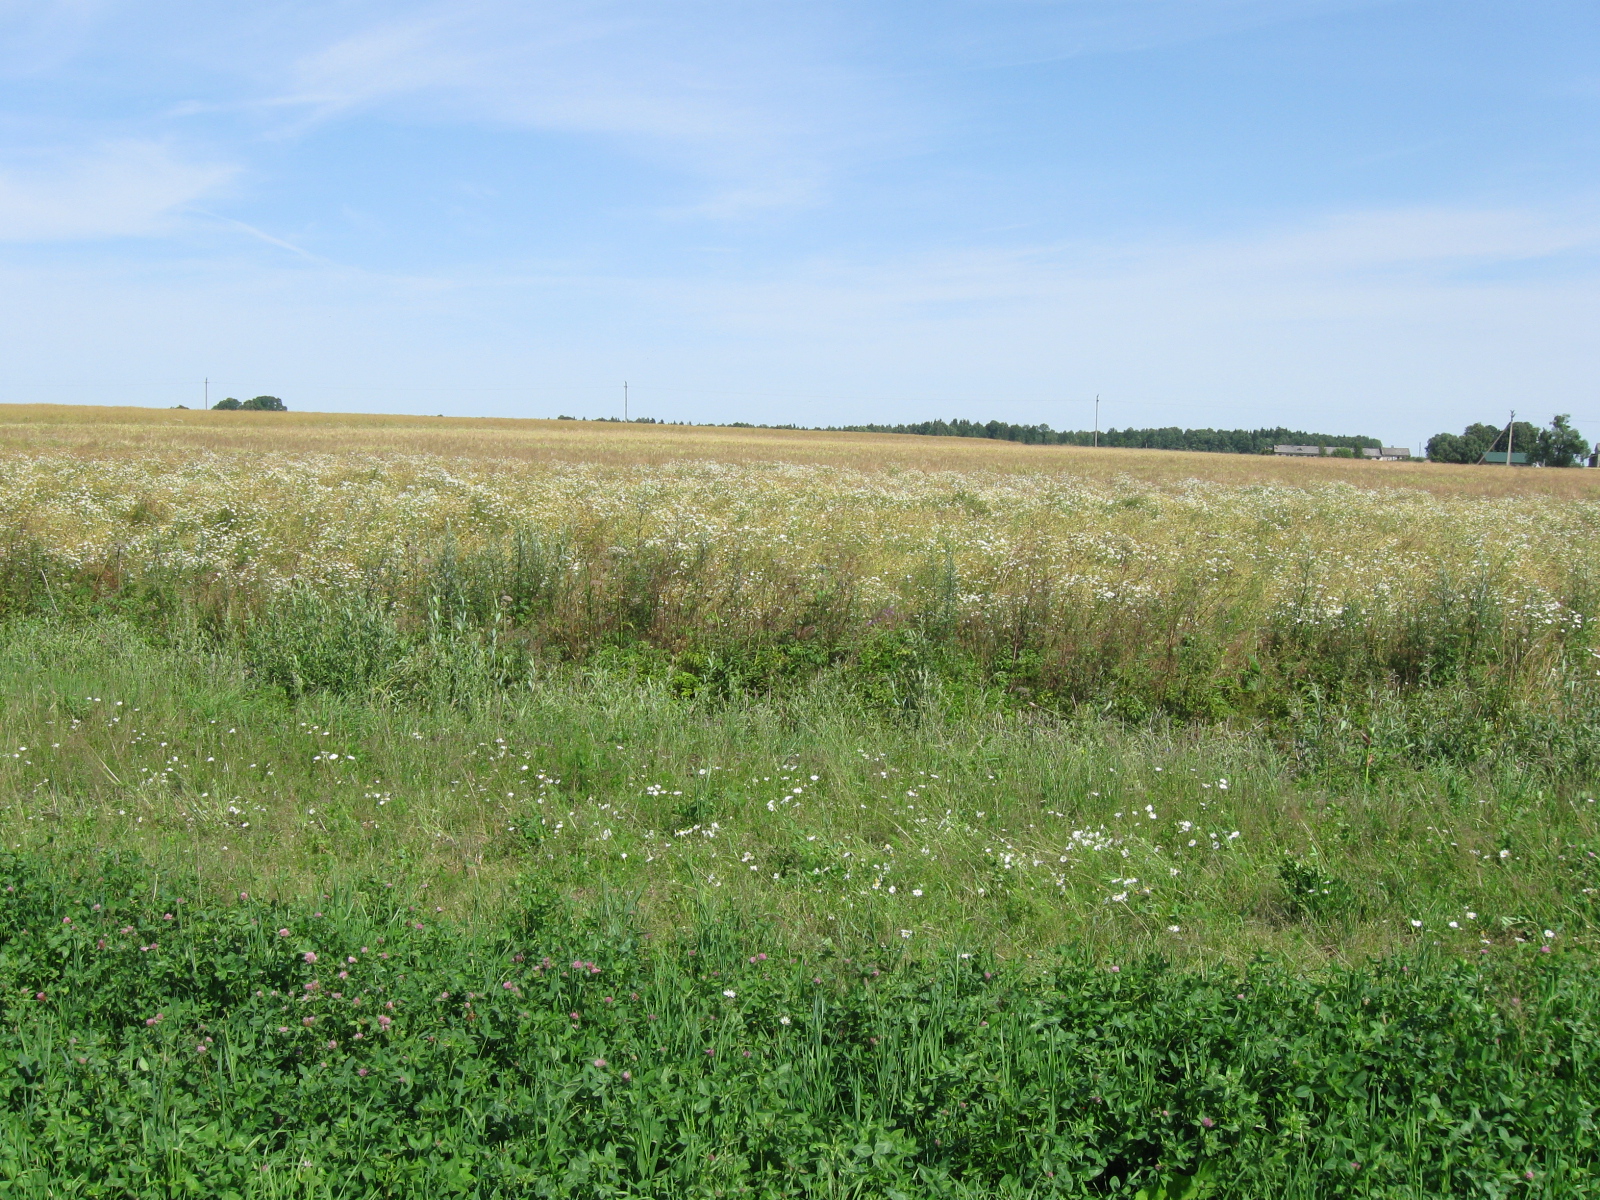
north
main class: Cropland
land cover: Clovers
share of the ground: > 75 %
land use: Agriculture (excluding fallow land and kitchen gardens)
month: July
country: LT
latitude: 54.7148
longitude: 23.8891
